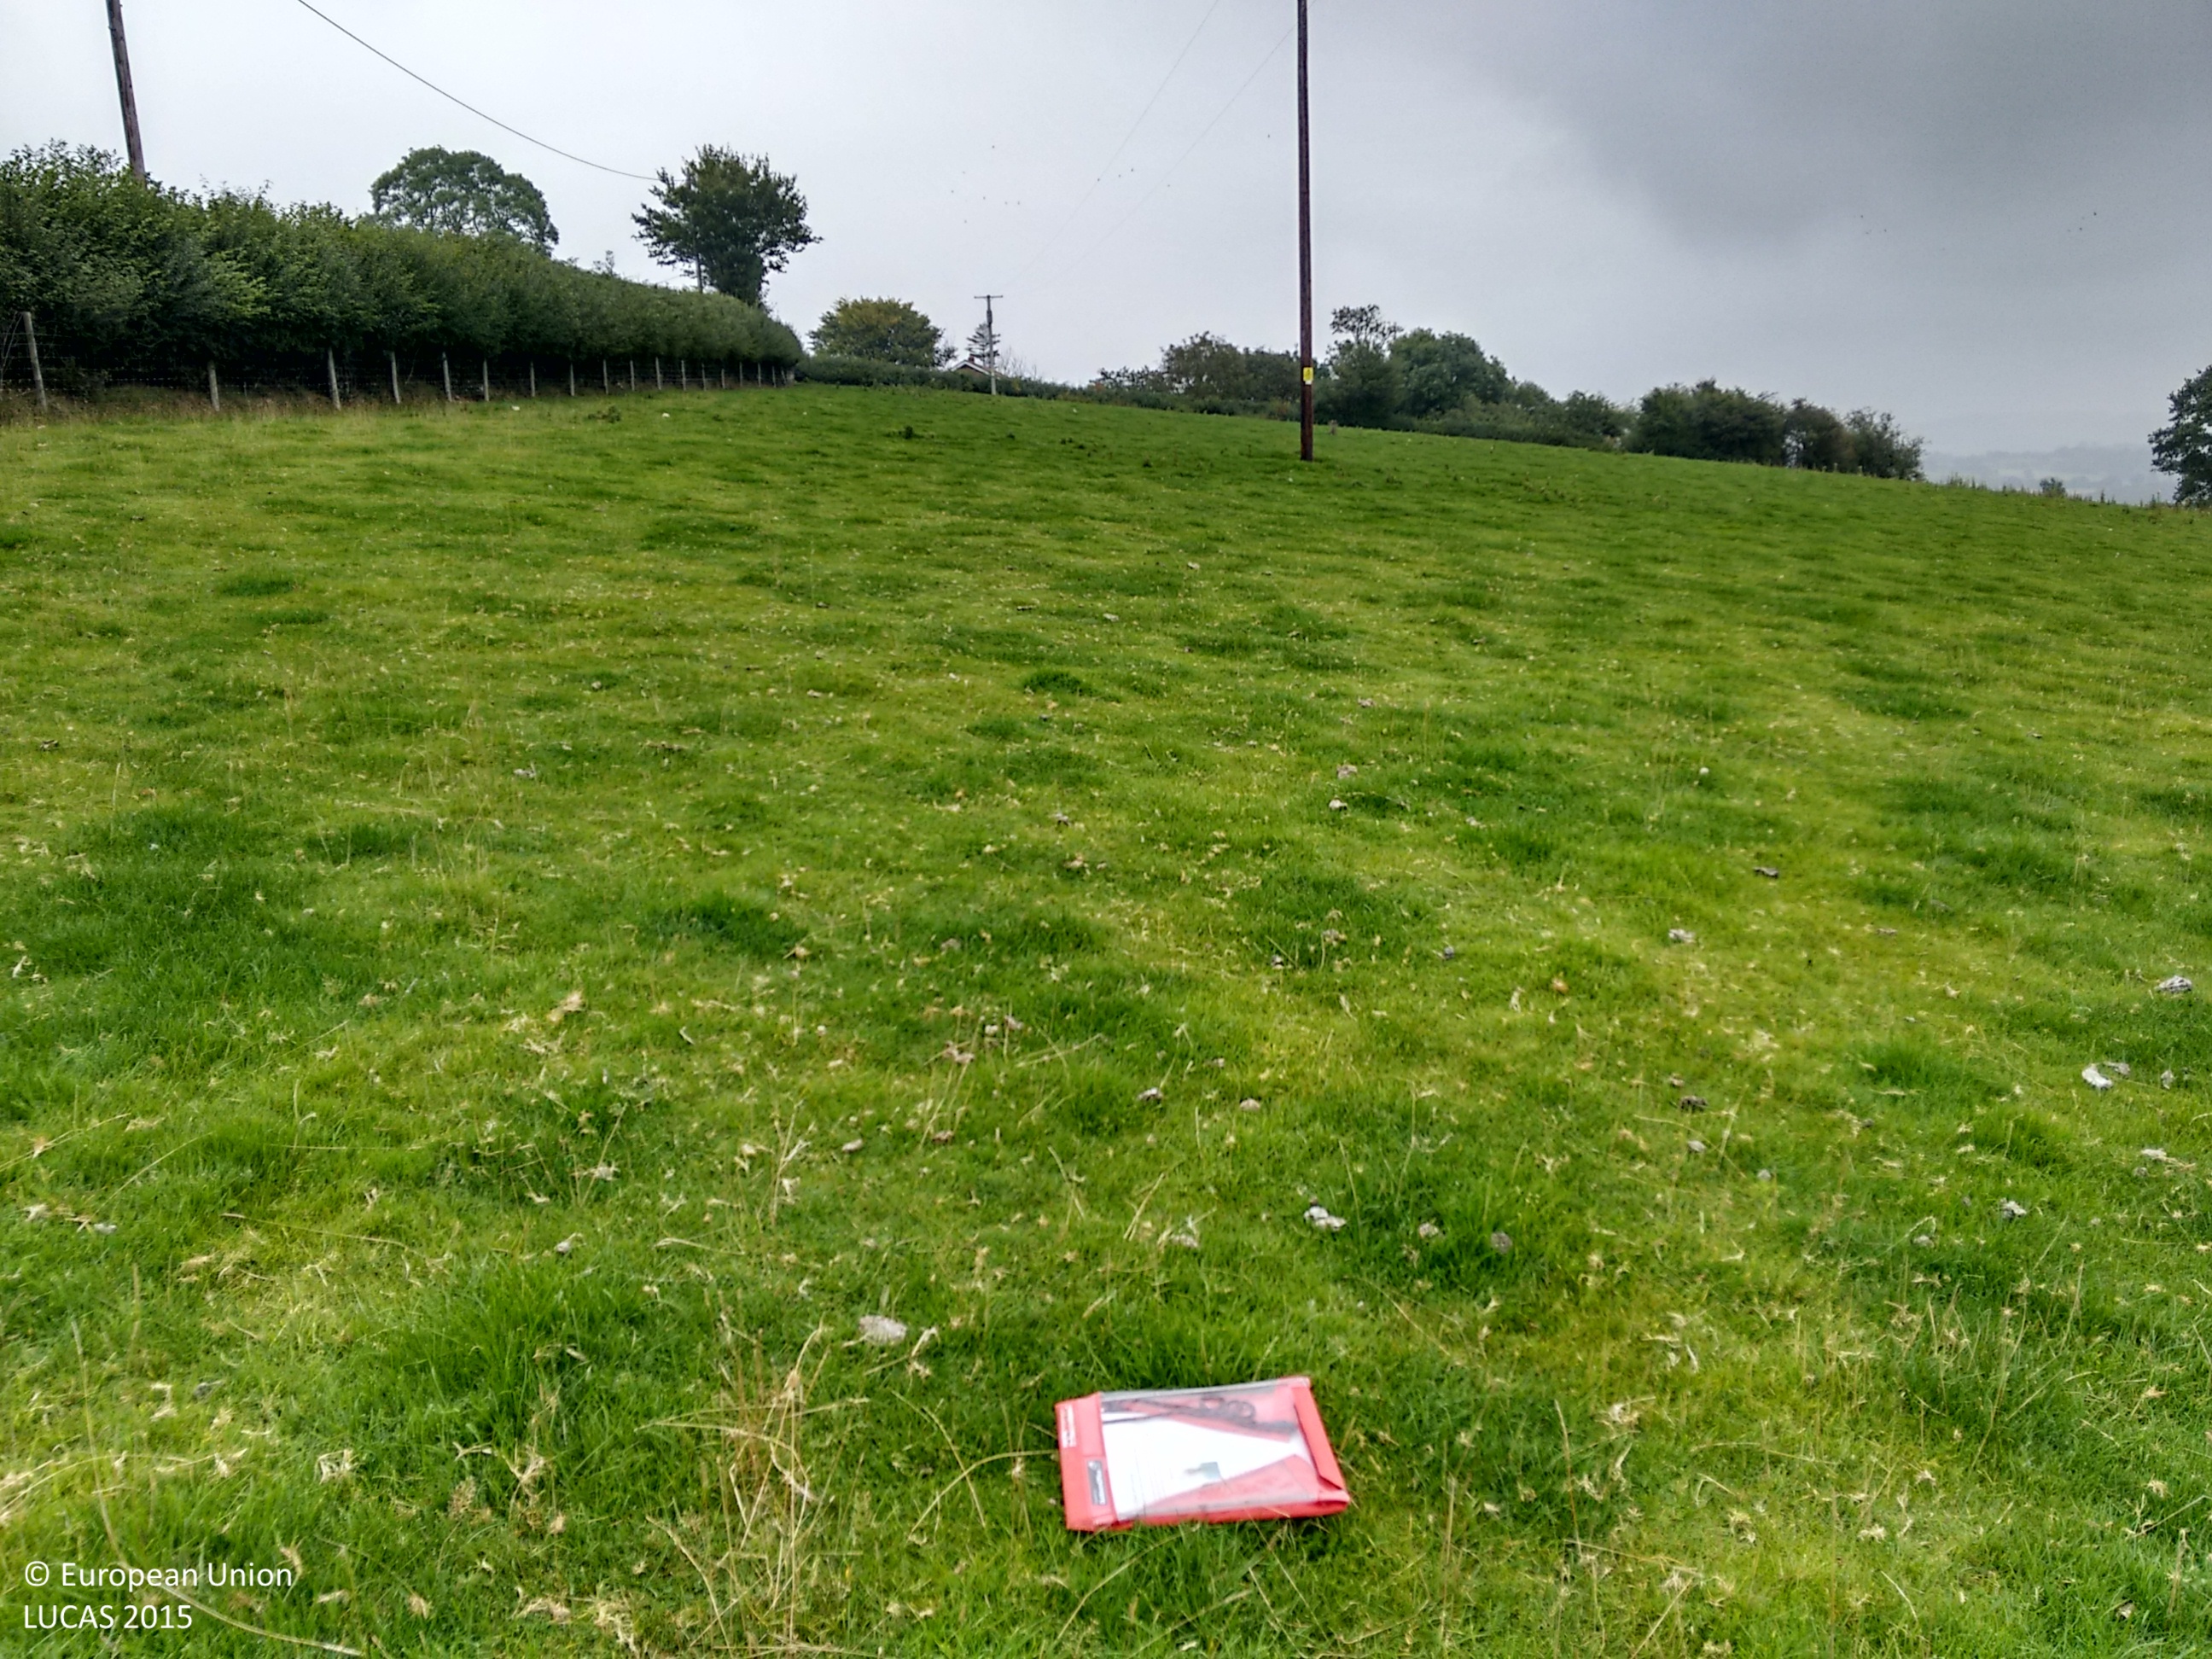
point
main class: Grassland
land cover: Grassland without tree/shrub cover
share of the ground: > 75 %
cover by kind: herbaceous plants 100 %
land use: Agriculture (excluding fallow land and kitchen gardens)
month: September
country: GB
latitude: 52.0983
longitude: -3.1428
